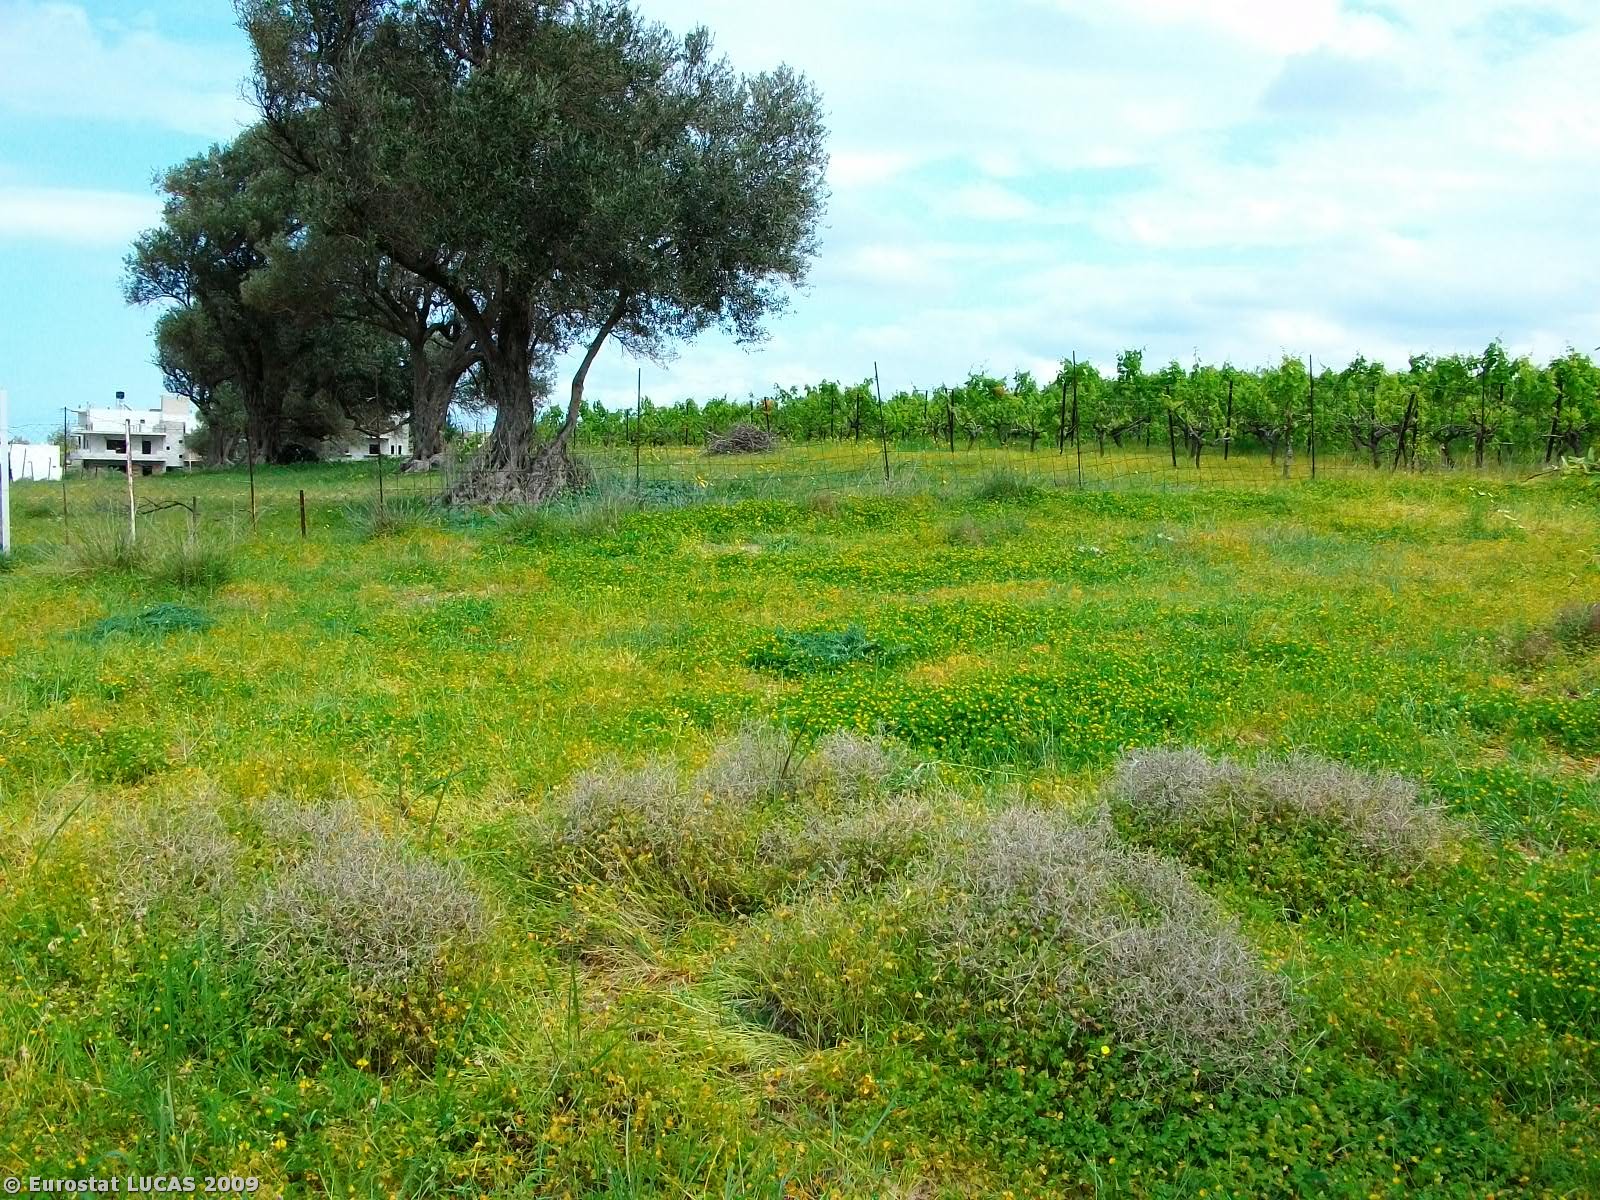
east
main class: Grassland
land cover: Grassland without tree/shrub cover
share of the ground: > 75 %
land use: Fallow land
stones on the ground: < 10 %
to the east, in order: Grassland without tree/shrub cover; Fences; Olive groves; Permanent crops (only in case pi); Artificial constructions in urban areas; Paved roads, cycling and walking lanes; Artificial constructions in urban areas; Vineyards
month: April
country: GR
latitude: 35.3224
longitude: 25.0735
